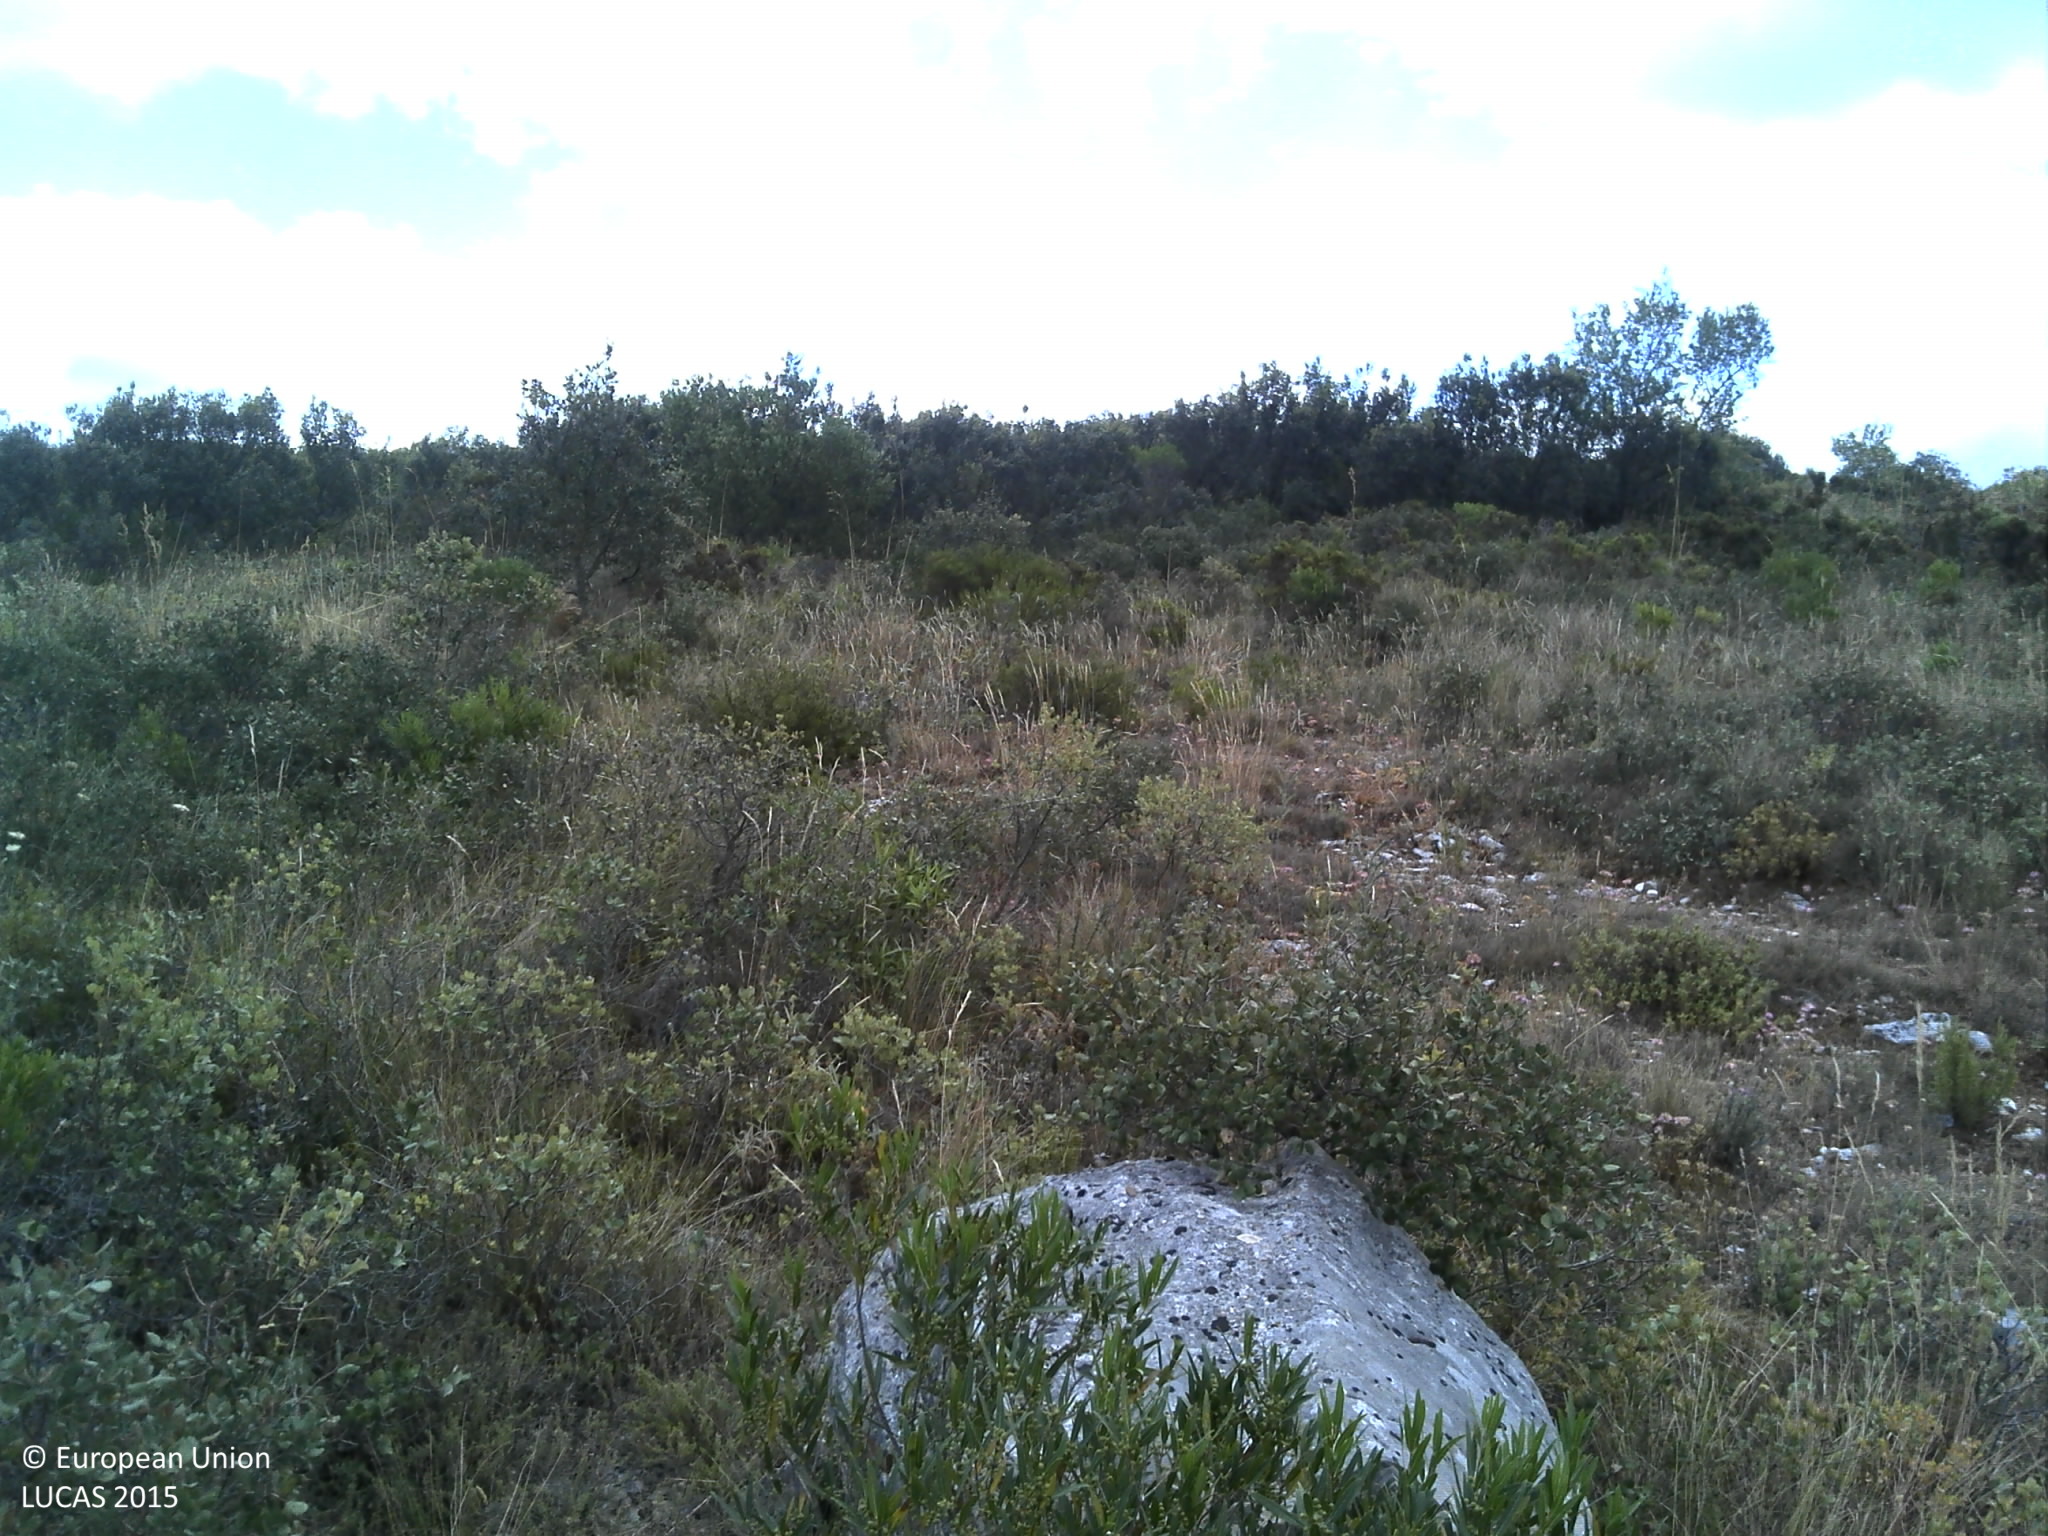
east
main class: Shrubland
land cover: Shrubland with sparse tree cover
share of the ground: 25 - 50 %
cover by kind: shrubs 50 %, unconsolidated bare surface 30 %, herbaceous plants 10 %, broadleaved forest trees 5 %, consolidated bare surface 5 %
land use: Abandoned areas
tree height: < 5 m
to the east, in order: Shrubland with sparse tree cover; Tracks; Shrubland with sparse tree cover; Tracks; Shrubland with sparse tree cover; Tracks; Shrubland with sparse tree cover; Tracks; Shrubland with sparse tree cover
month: June
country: PT
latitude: 39.4671
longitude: -8.8059
